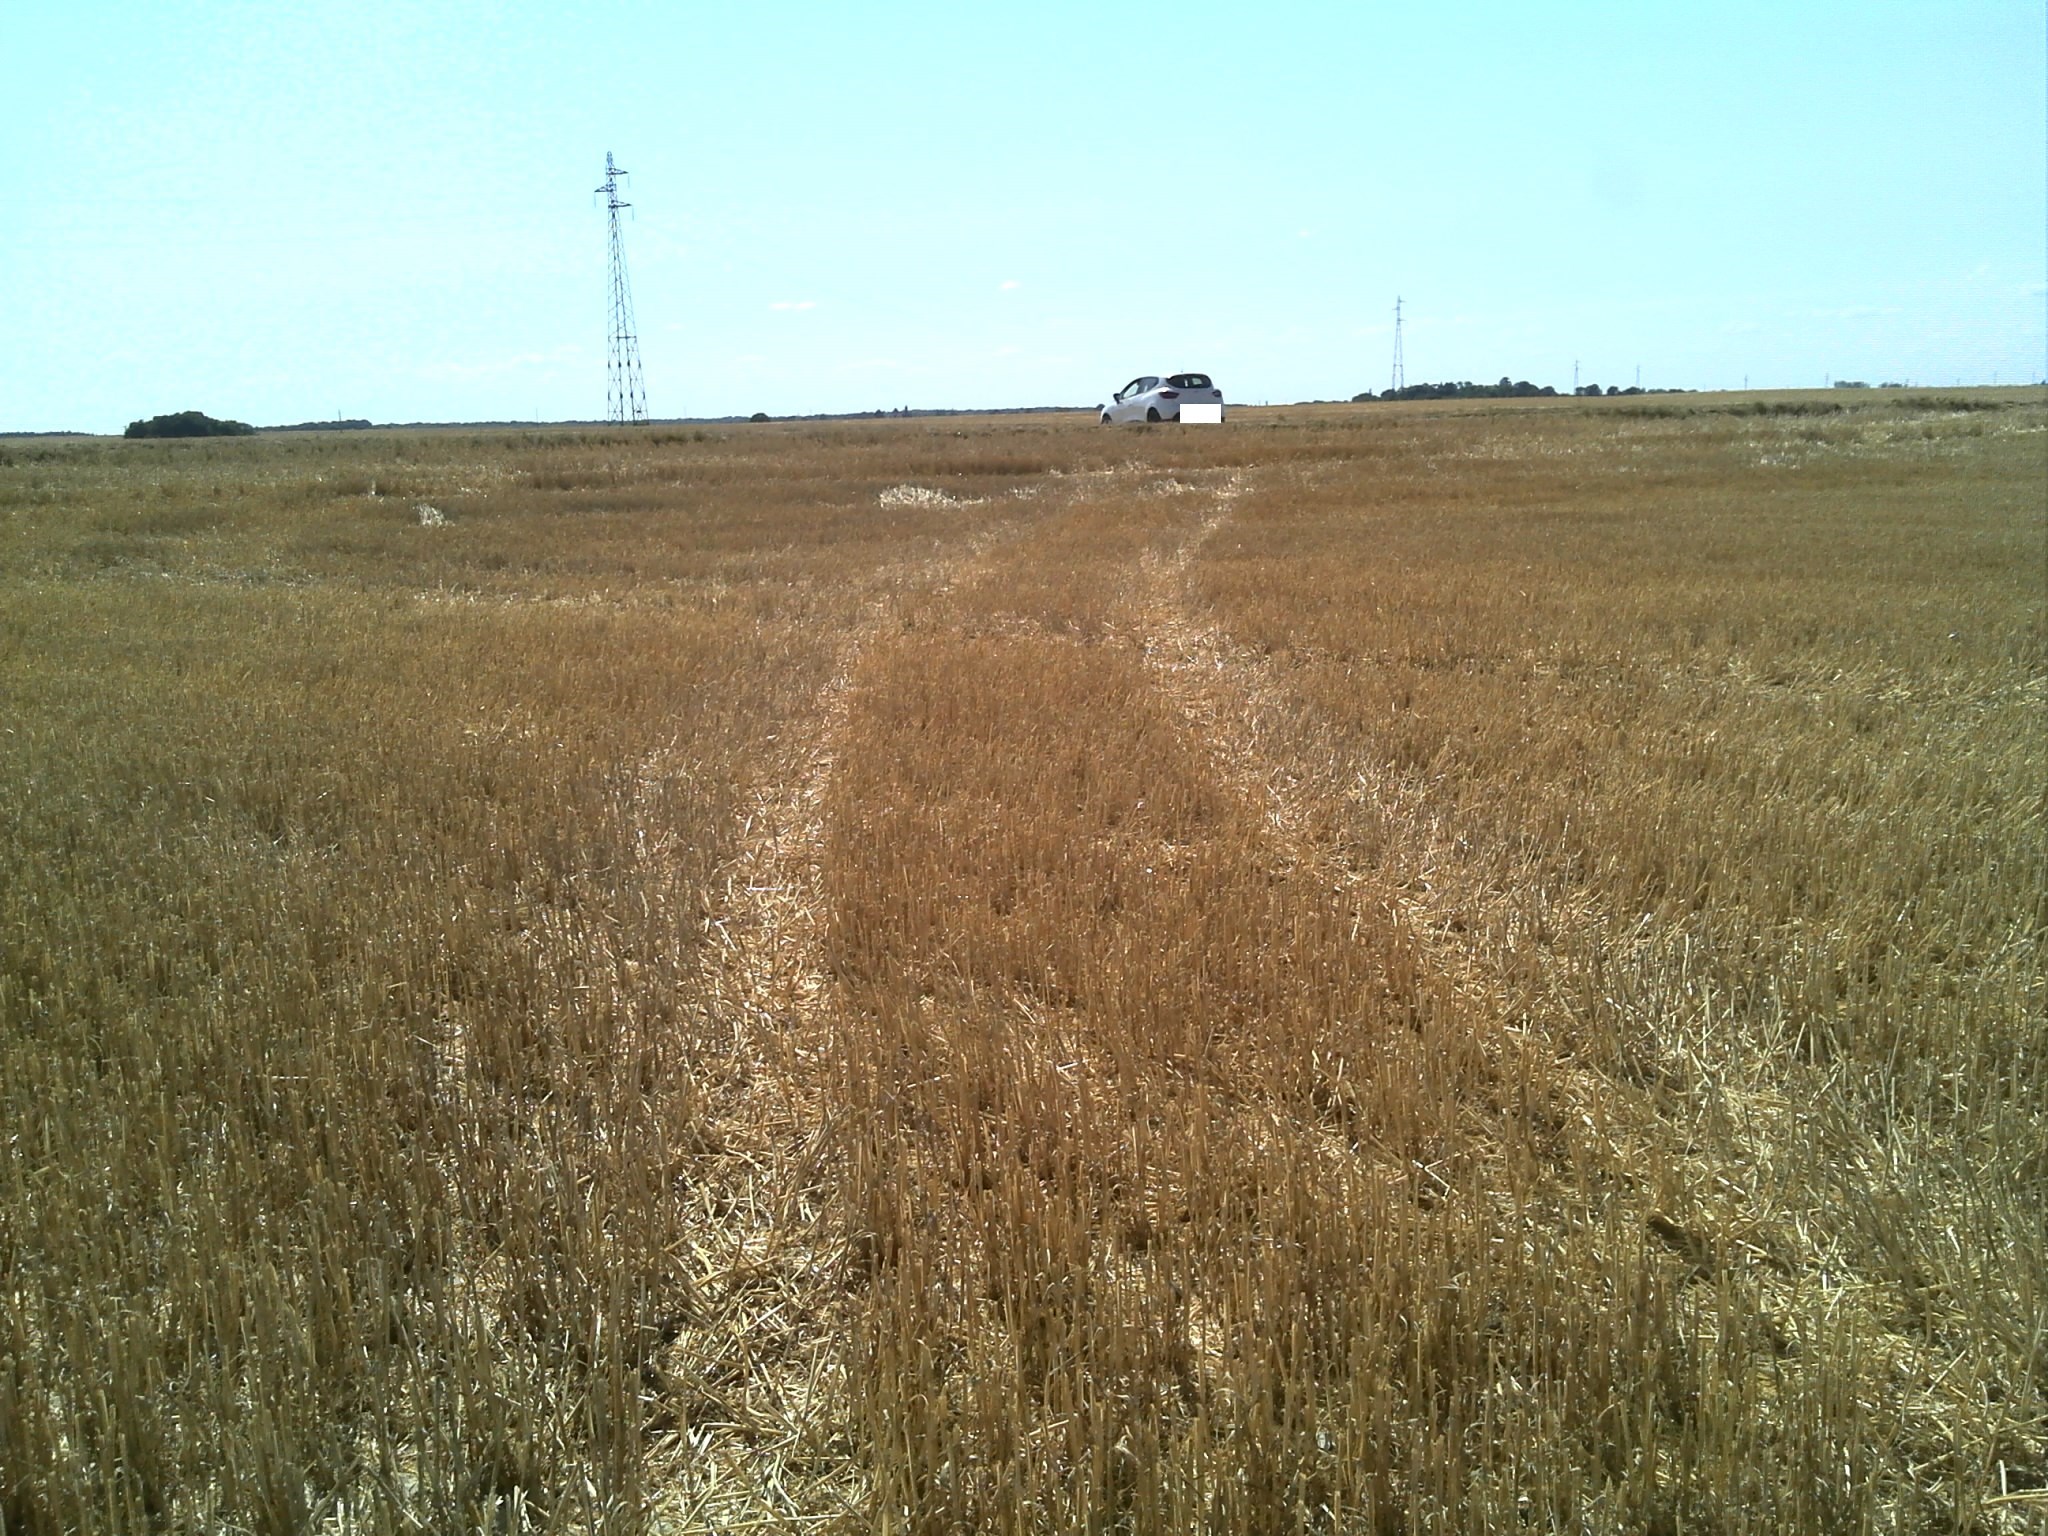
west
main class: Cropland
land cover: Durum wheat
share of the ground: > 75 %
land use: Agriculture (excluding fallow land and kitchen gardens)
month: July
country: FR
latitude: 46.8434
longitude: 1.4780
